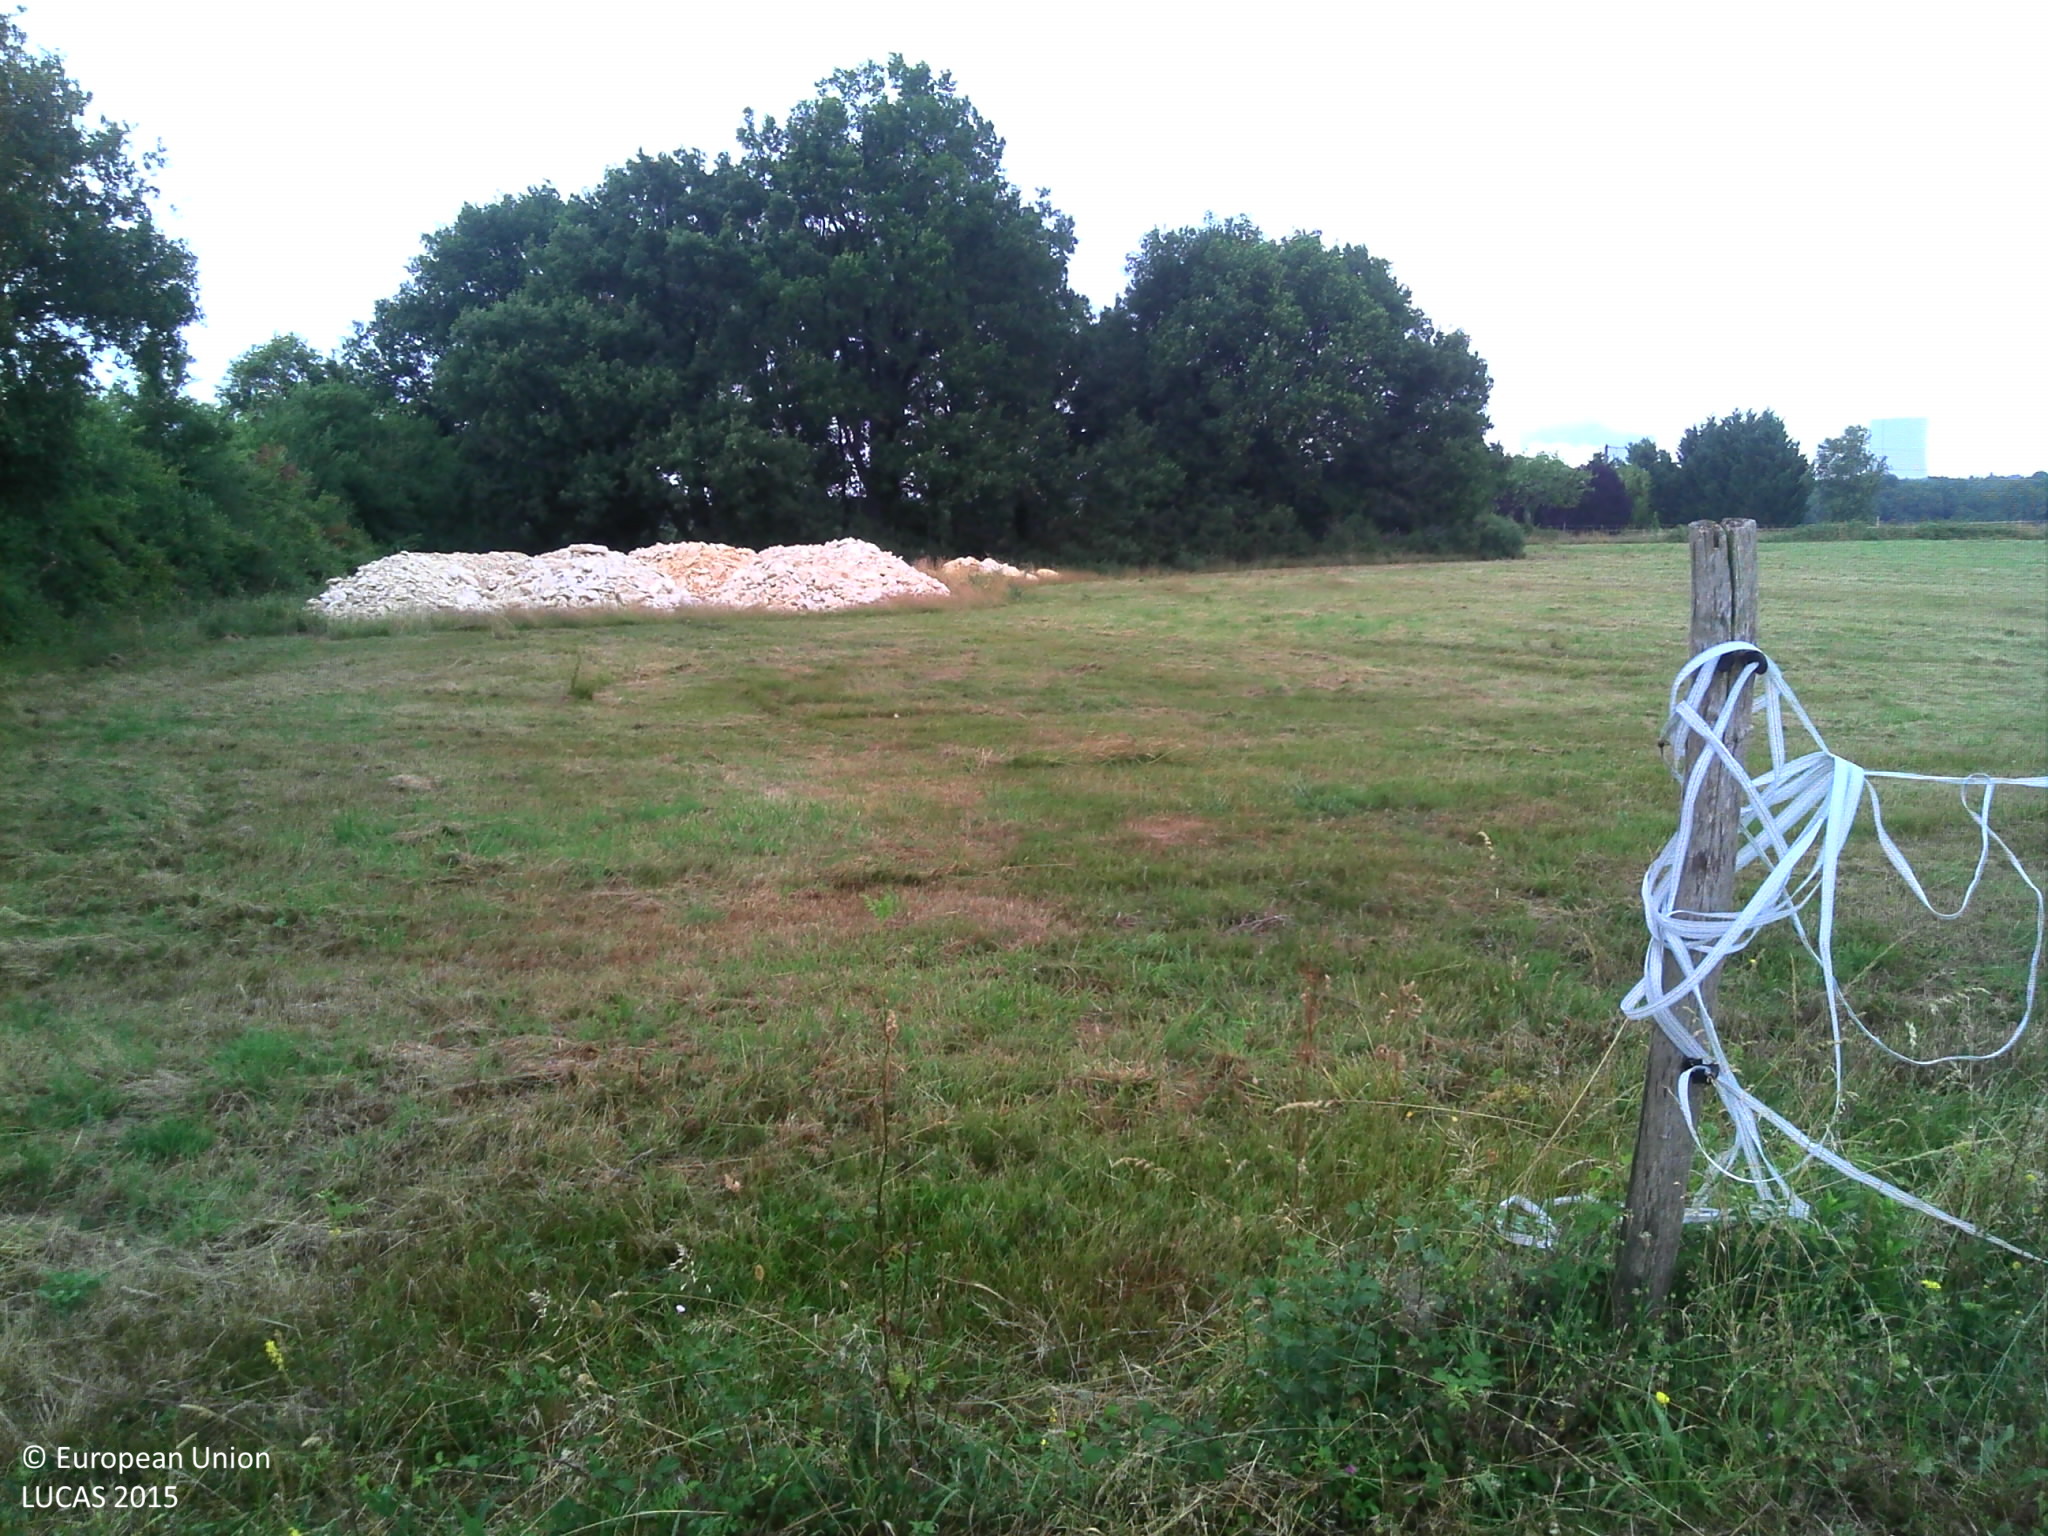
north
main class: Grassland
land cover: Grassland without tree/shrub cover
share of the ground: > 75 %
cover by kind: herbaceous plants 100 %
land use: Agriculture (excluding fallow land and kitchen gardens)
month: July
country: FR
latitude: 46.4283
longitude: 0.6274
